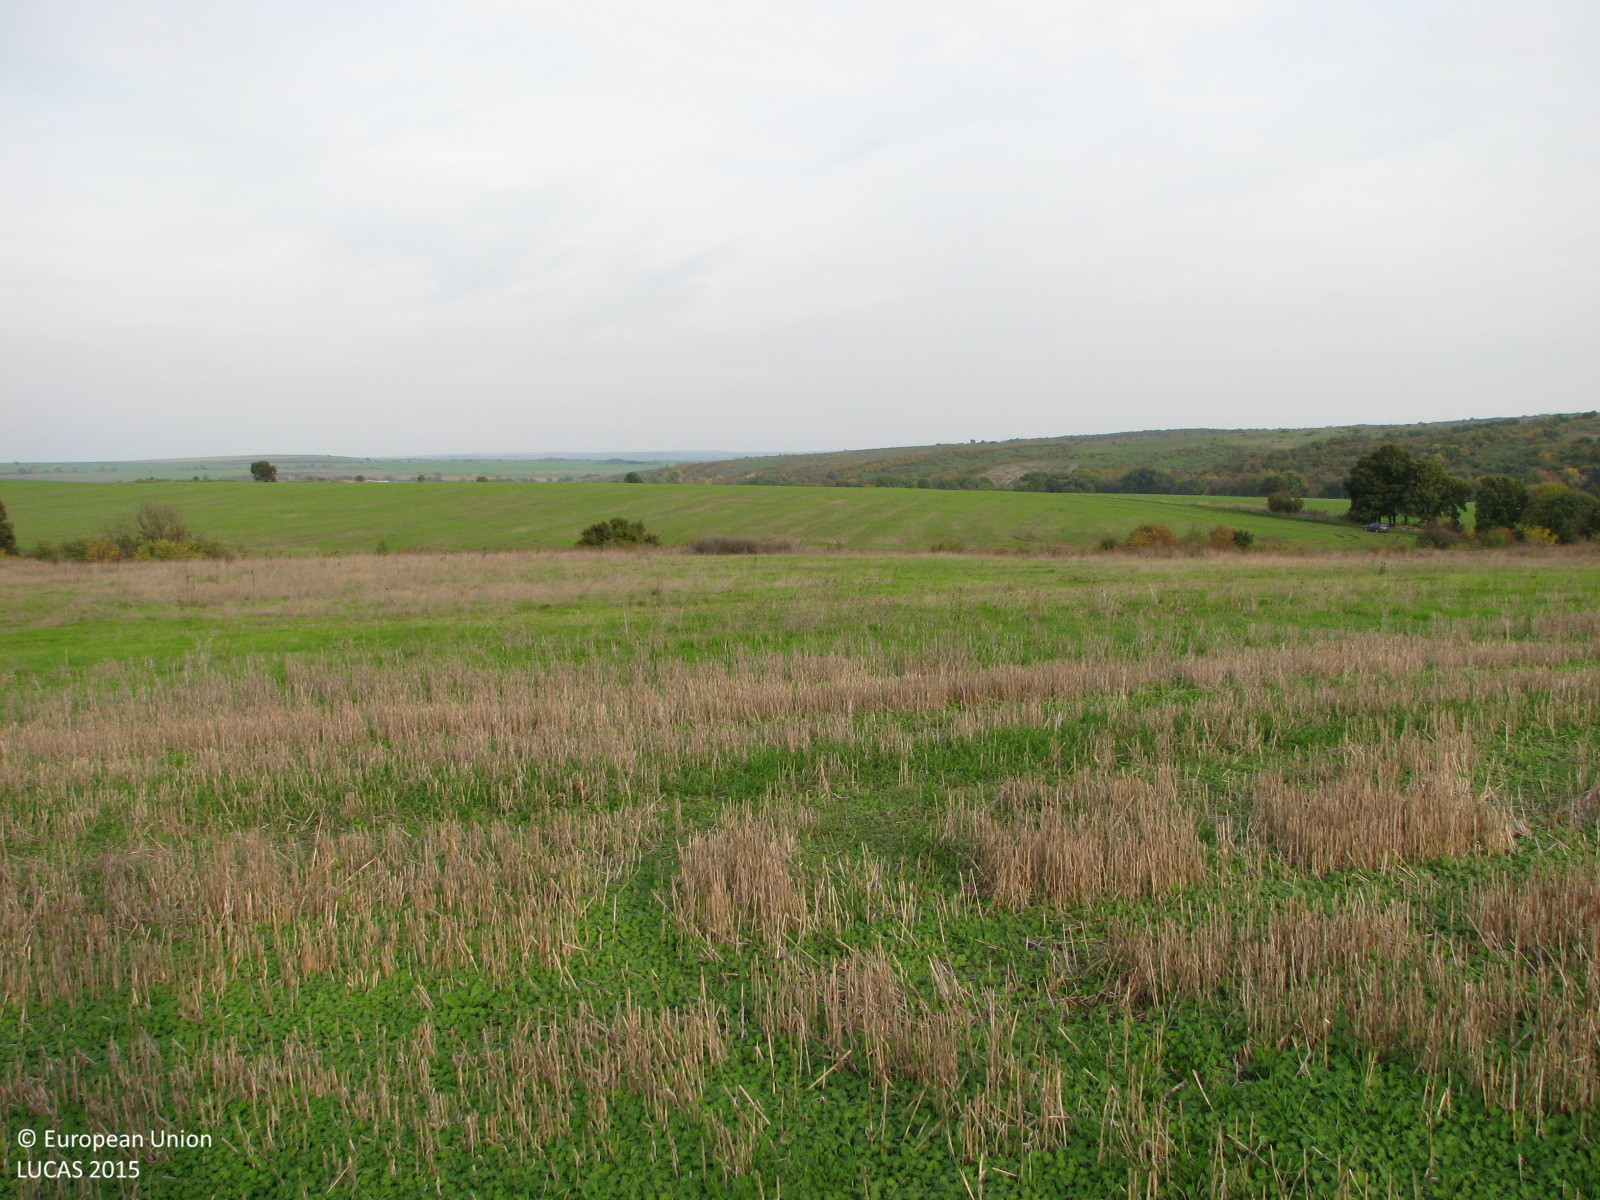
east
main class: Cropland
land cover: Common wheat
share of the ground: 25 - 50 %
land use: Agriculture (excluding fallow land and kitchen gardens)
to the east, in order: Common wheat; Shrubland with sparse tree cover; Grass margins; Rape and turnip rape
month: October
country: BG
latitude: 42.4116
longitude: 26.8317
